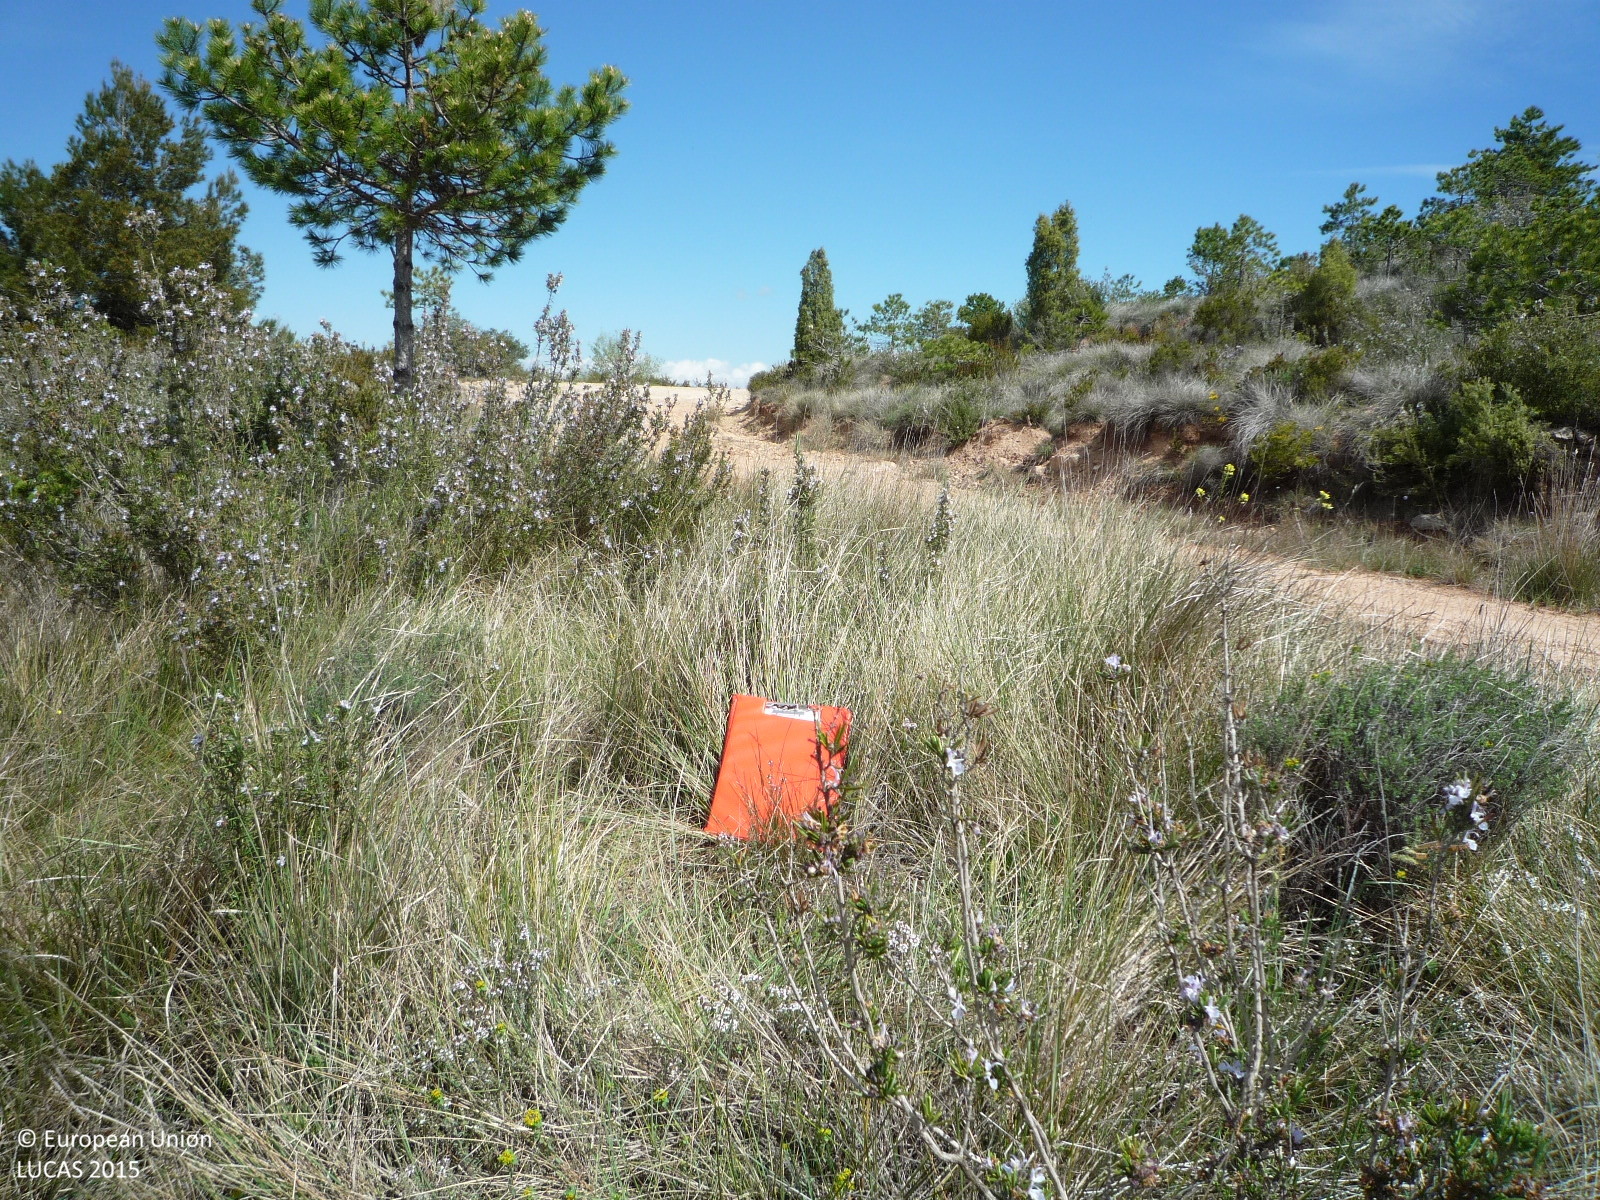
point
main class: Shrubland
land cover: Shrubland with sparse tree cover
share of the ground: > 75 %
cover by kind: shrubs 60 %, herbaceous plants 35 %, broadleaved forest trees 5 %
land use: Semi-natural and natural areas not in use
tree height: < 5 m
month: April
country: ES
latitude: 41.7107
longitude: 1.6620
